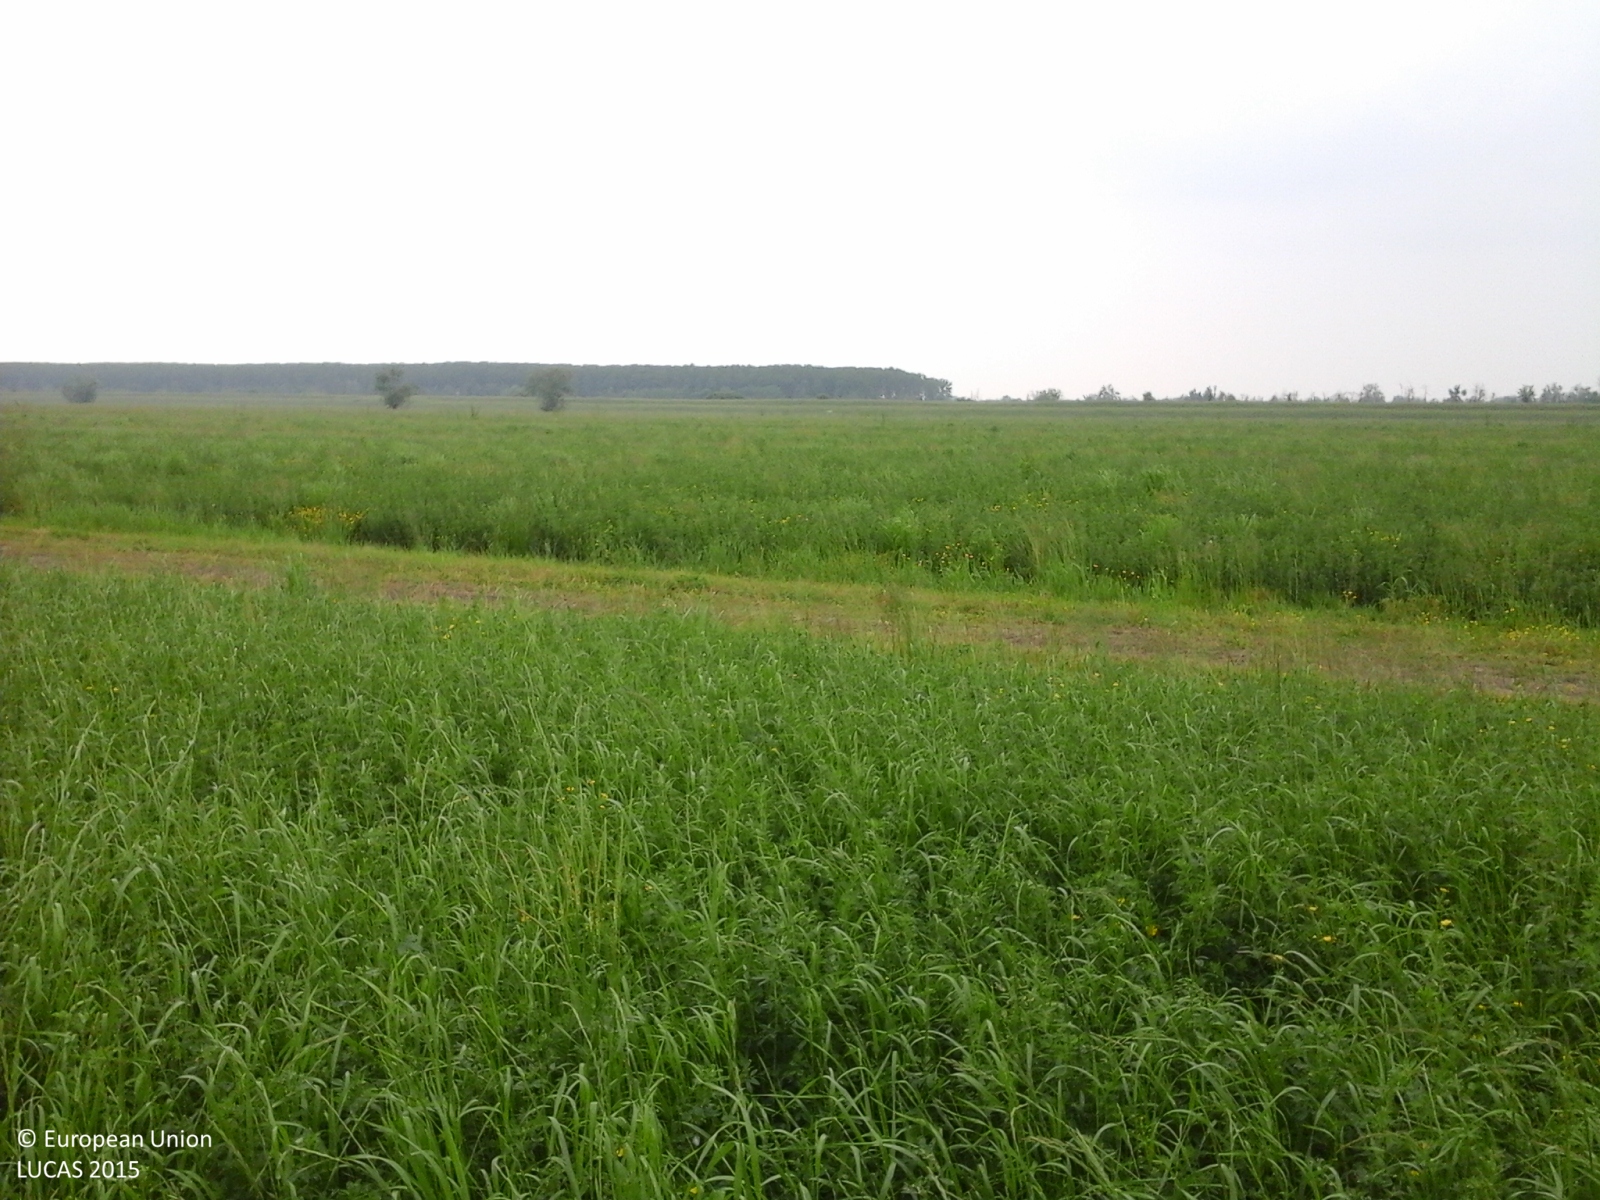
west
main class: Cropland
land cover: Lucerne
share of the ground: > 75 %
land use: Agriculture (excluding fallow land and kitchen gardens)
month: May
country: IT
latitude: 44.8889
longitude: 10.7455
